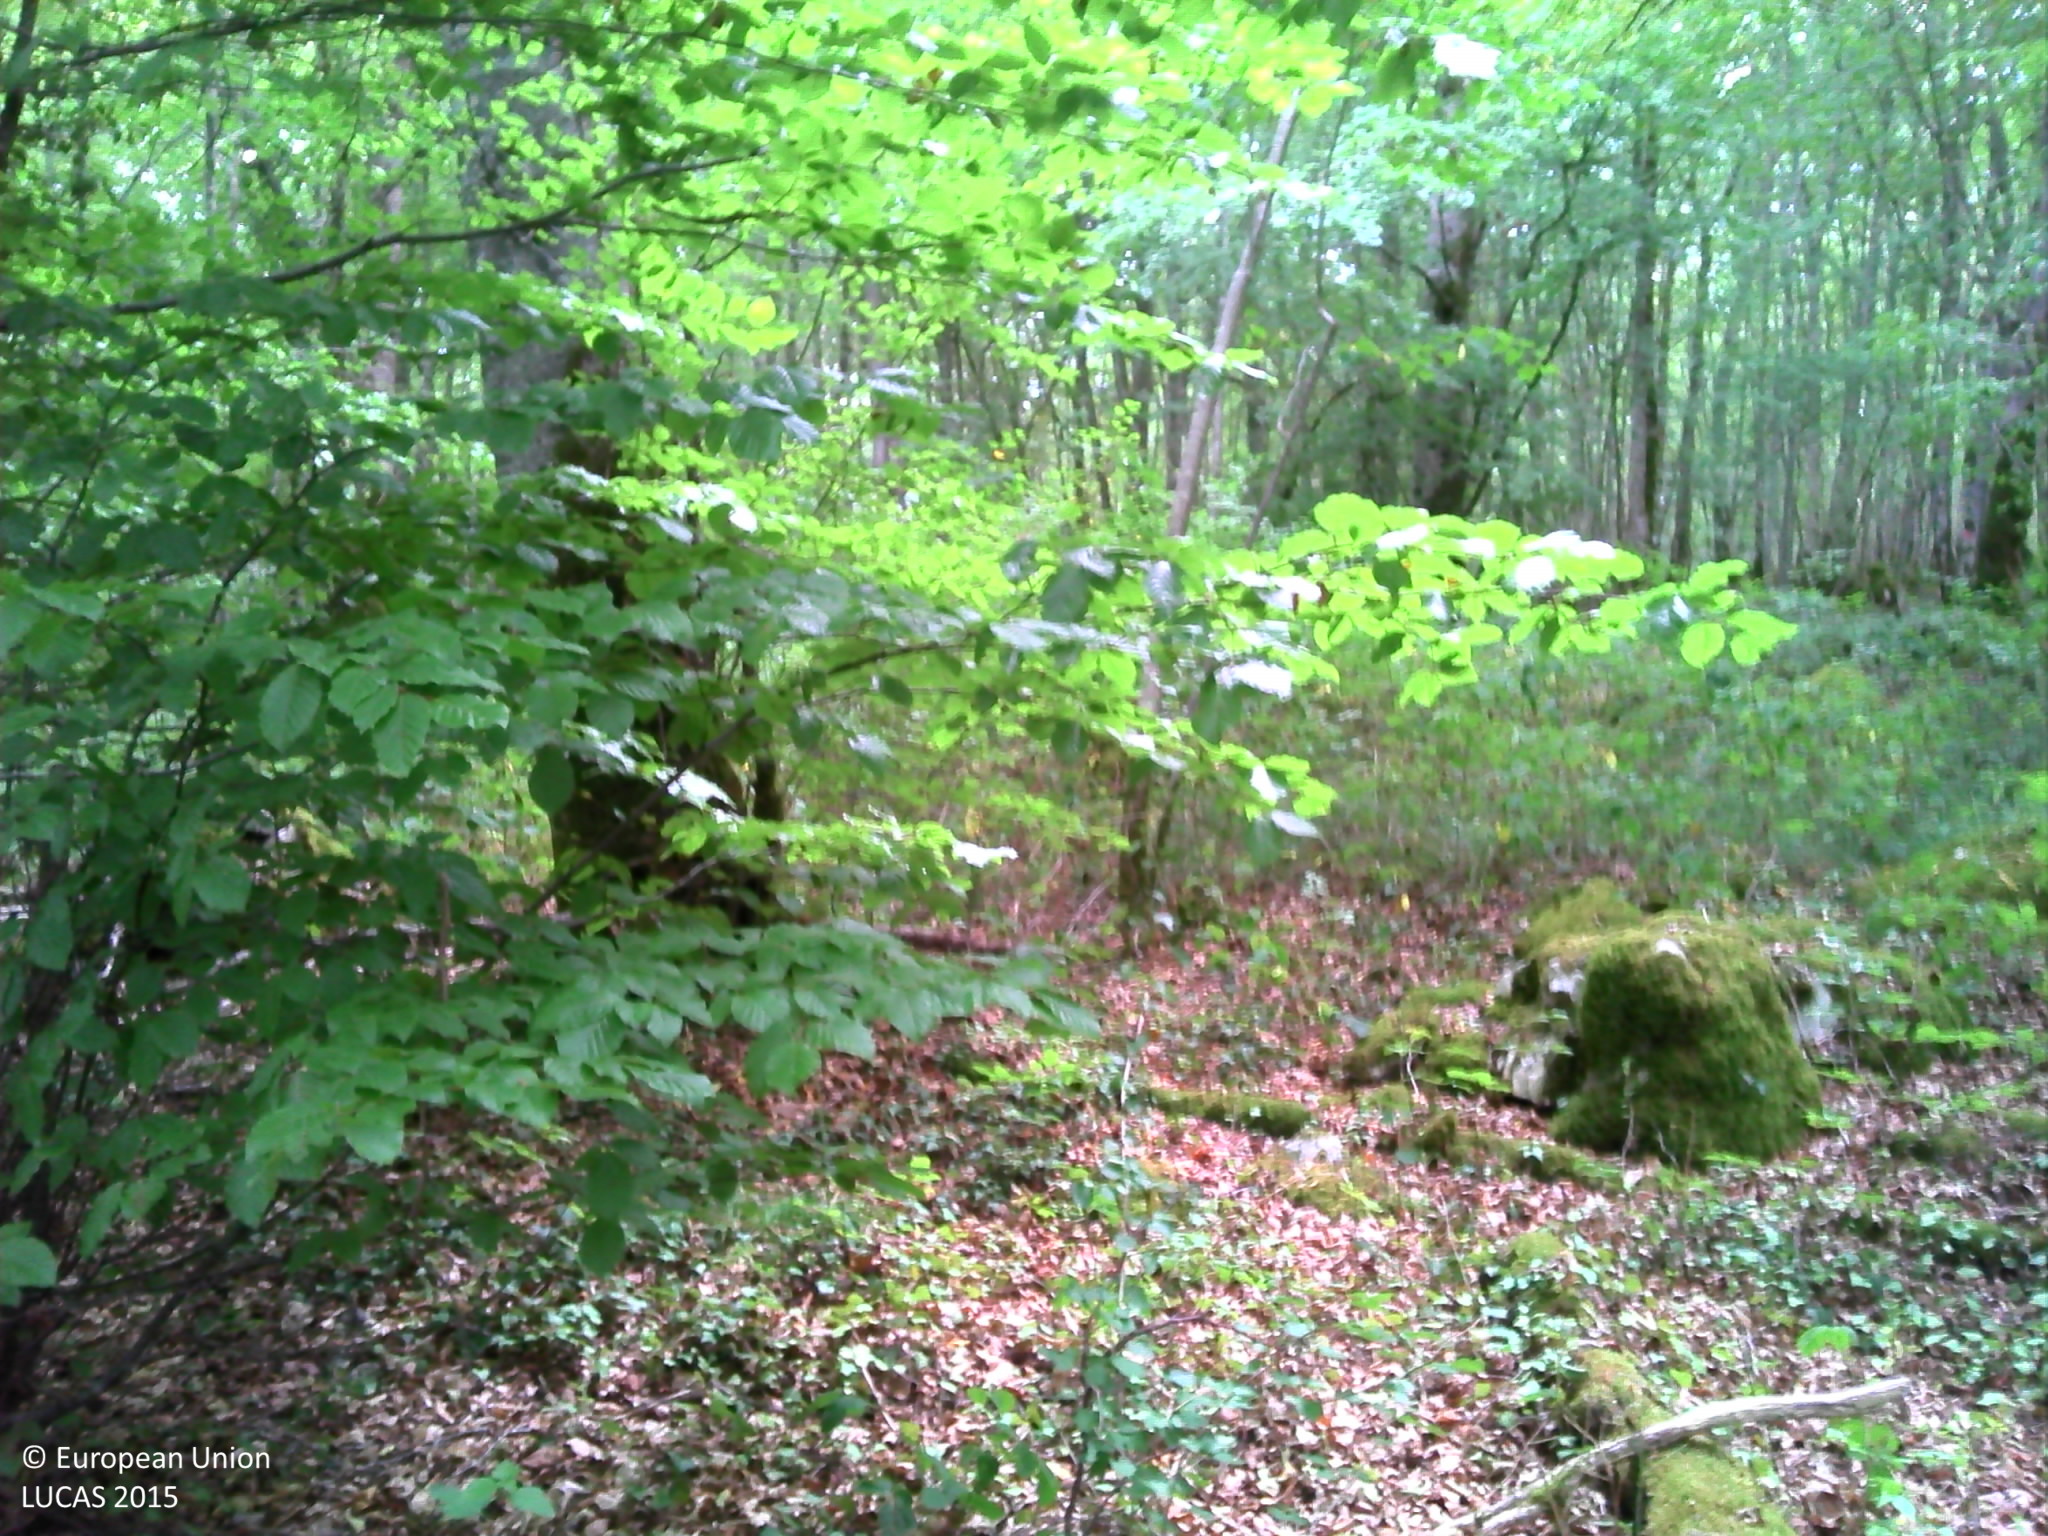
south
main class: Woodland
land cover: Broadleaved woodland
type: beech forest
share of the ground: > 75 %
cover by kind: broadleaved forest trees 90 %, herbaceous plants 5 %, lichens and mosses 5 %
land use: Forestry
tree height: > 5 m
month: August
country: FR
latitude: 47.7625
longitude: 4.8895
